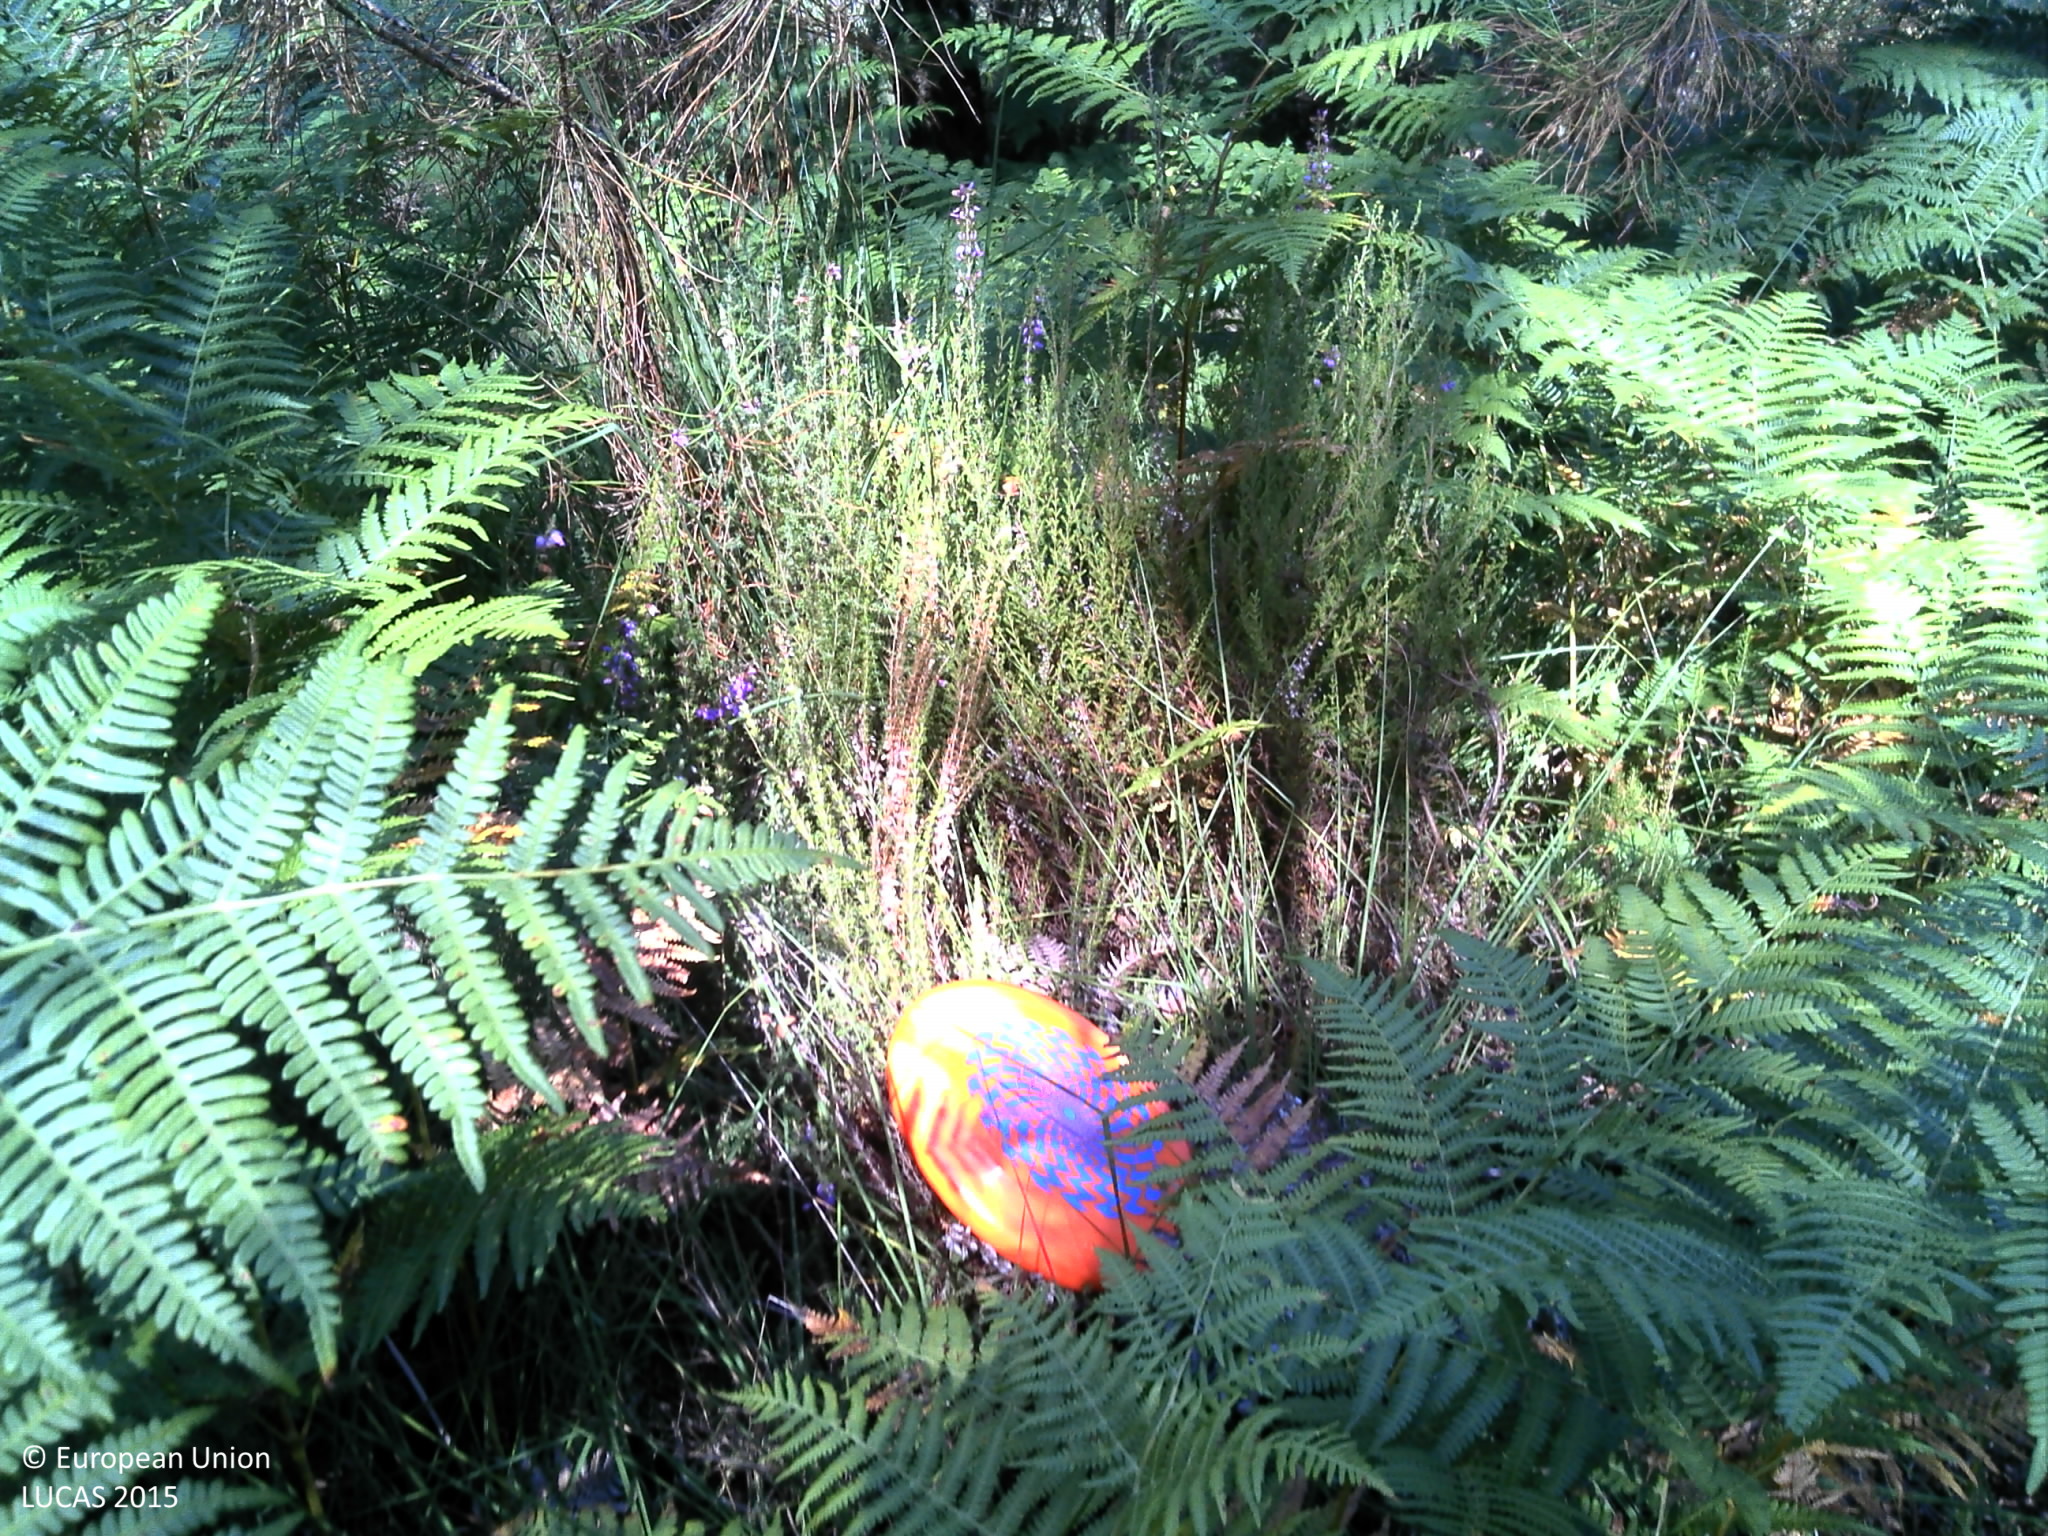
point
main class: Woodland
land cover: Pine dominated coniferous woodland
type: coniferous forest of the mediterranean region
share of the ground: > 75 %
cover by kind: coniferous forest trees 60 %, shrubs 30 %, herbaceous plants 5 %, lichens and mosses 5 %
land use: Forestry
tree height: > 5 m
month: August
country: FR
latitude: 45.0569
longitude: -0.9826
